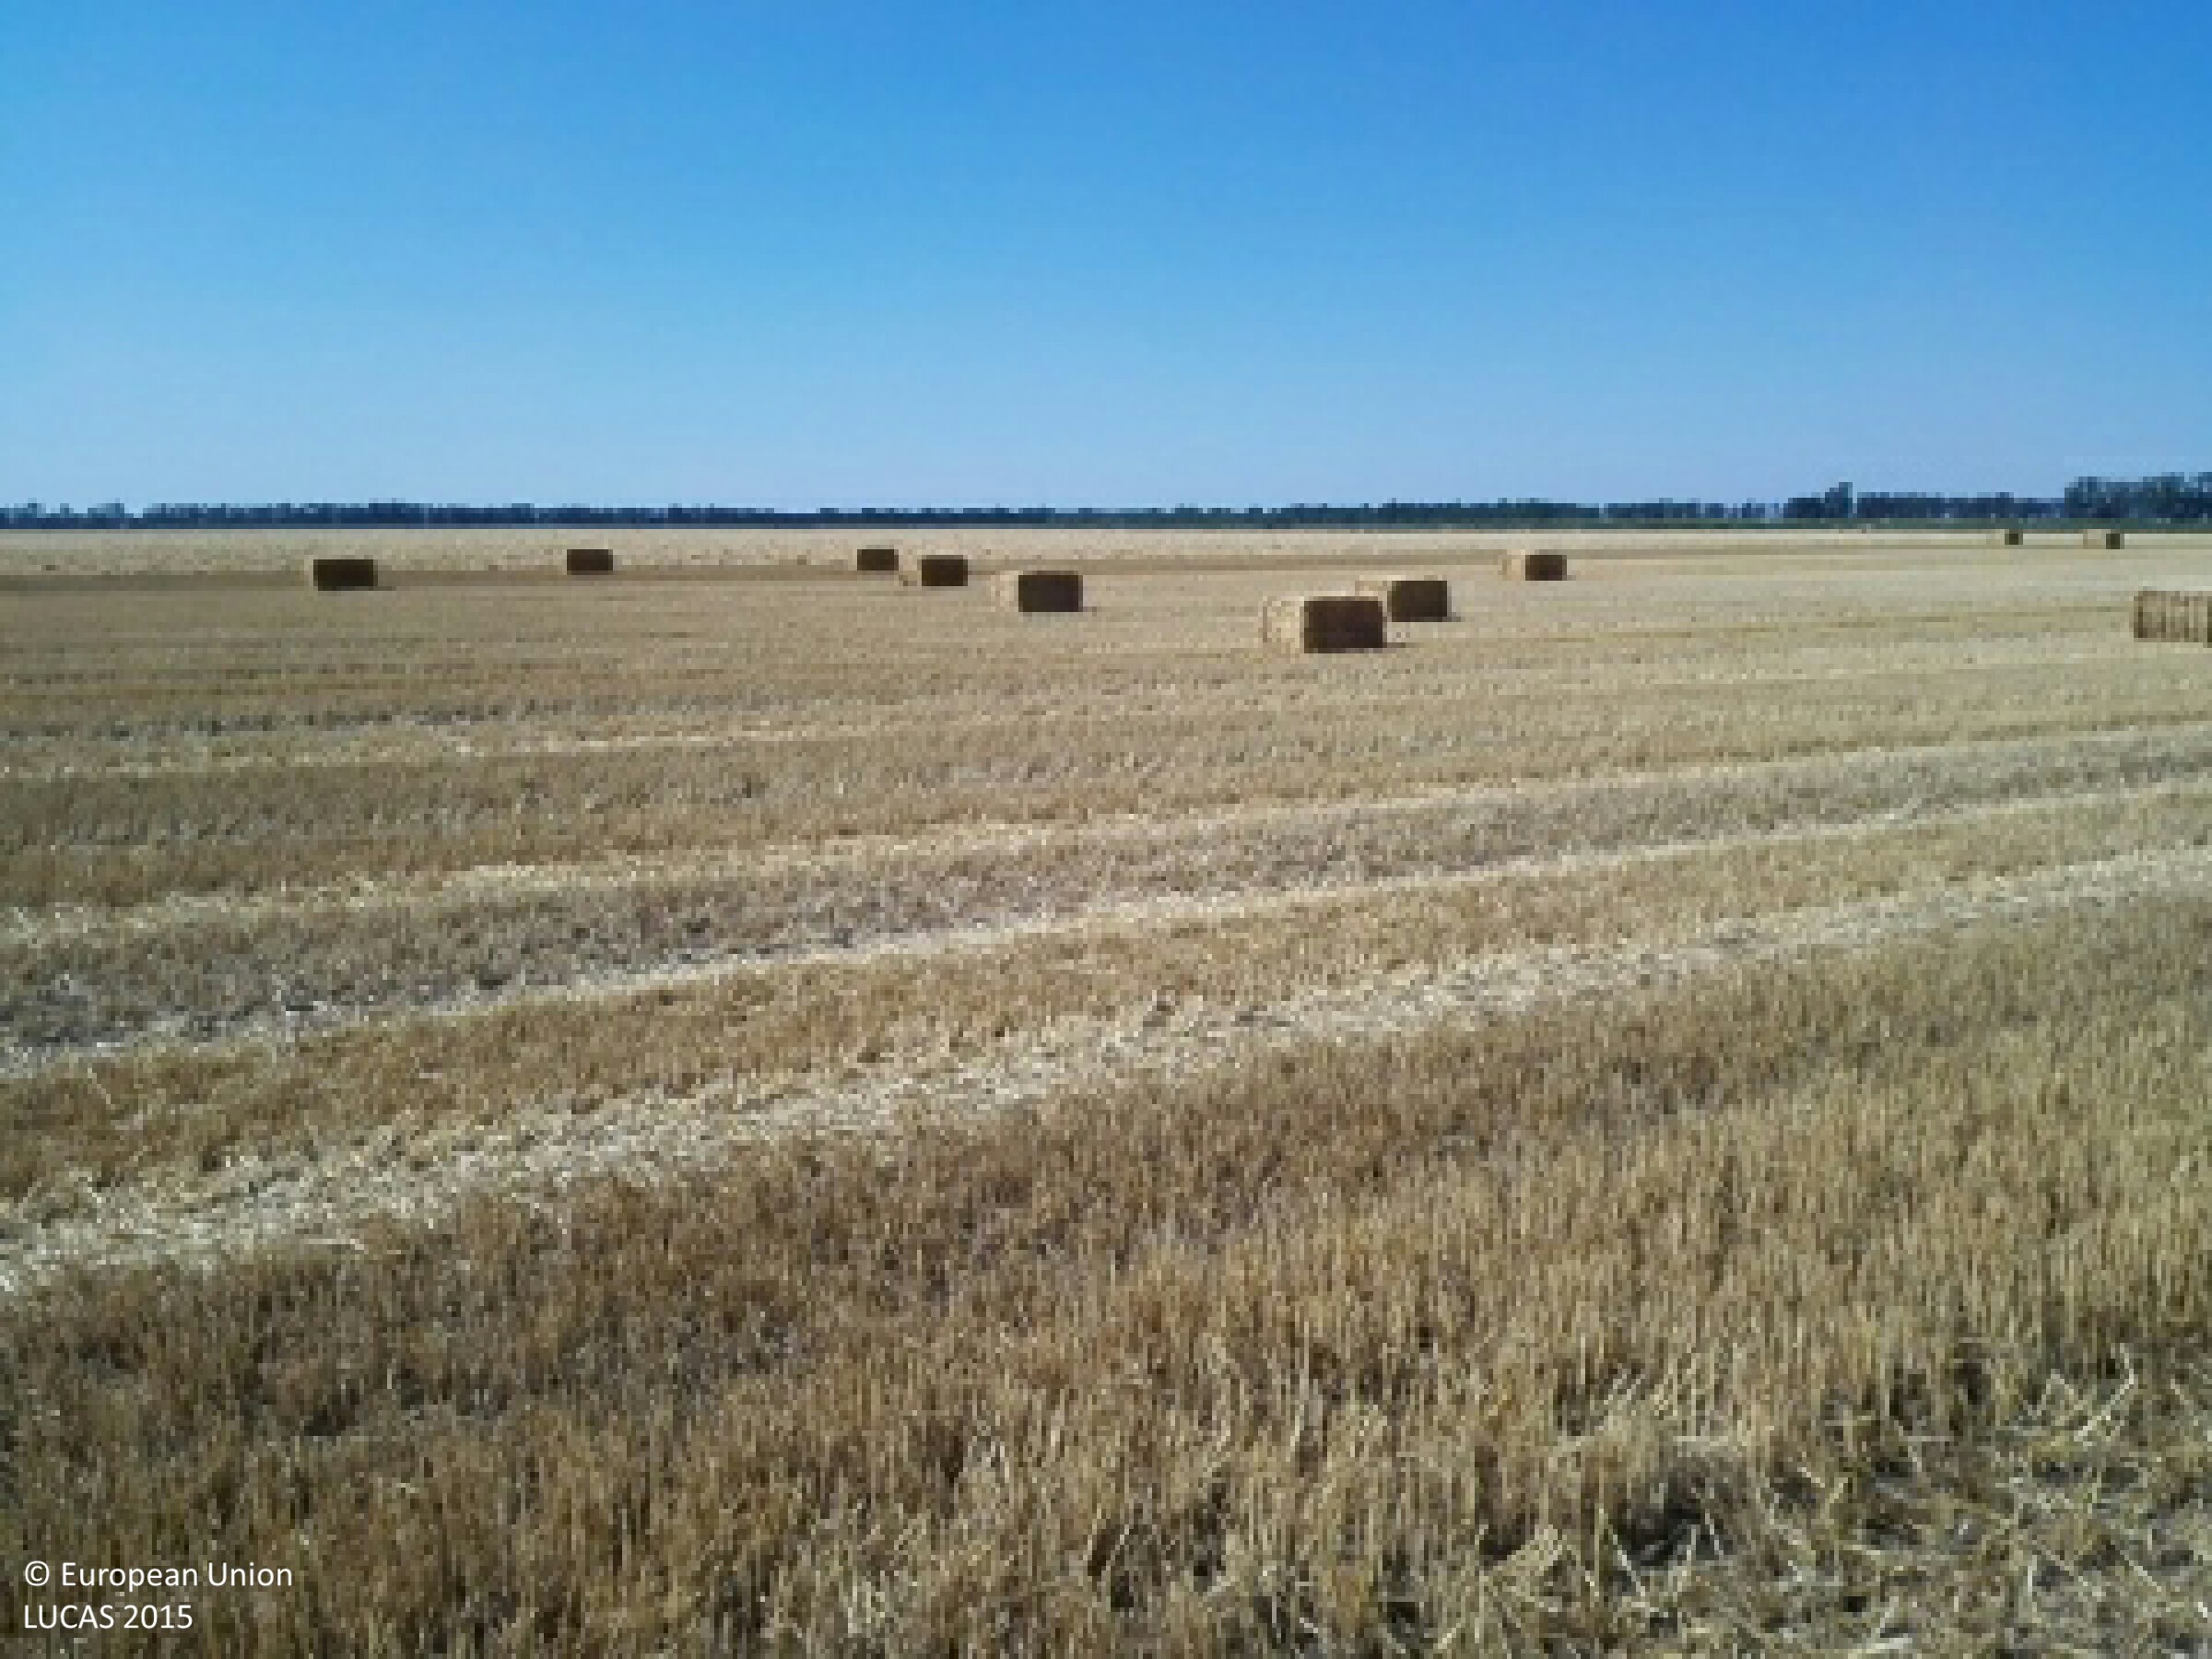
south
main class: Cropland
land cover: Common wheat
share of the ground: 50 - 75 %
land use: Agriculture (excluding fallow land and kitchen gardens)
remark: Harvested field
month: July
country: HU
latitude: 47.7139
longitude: 21.4666
